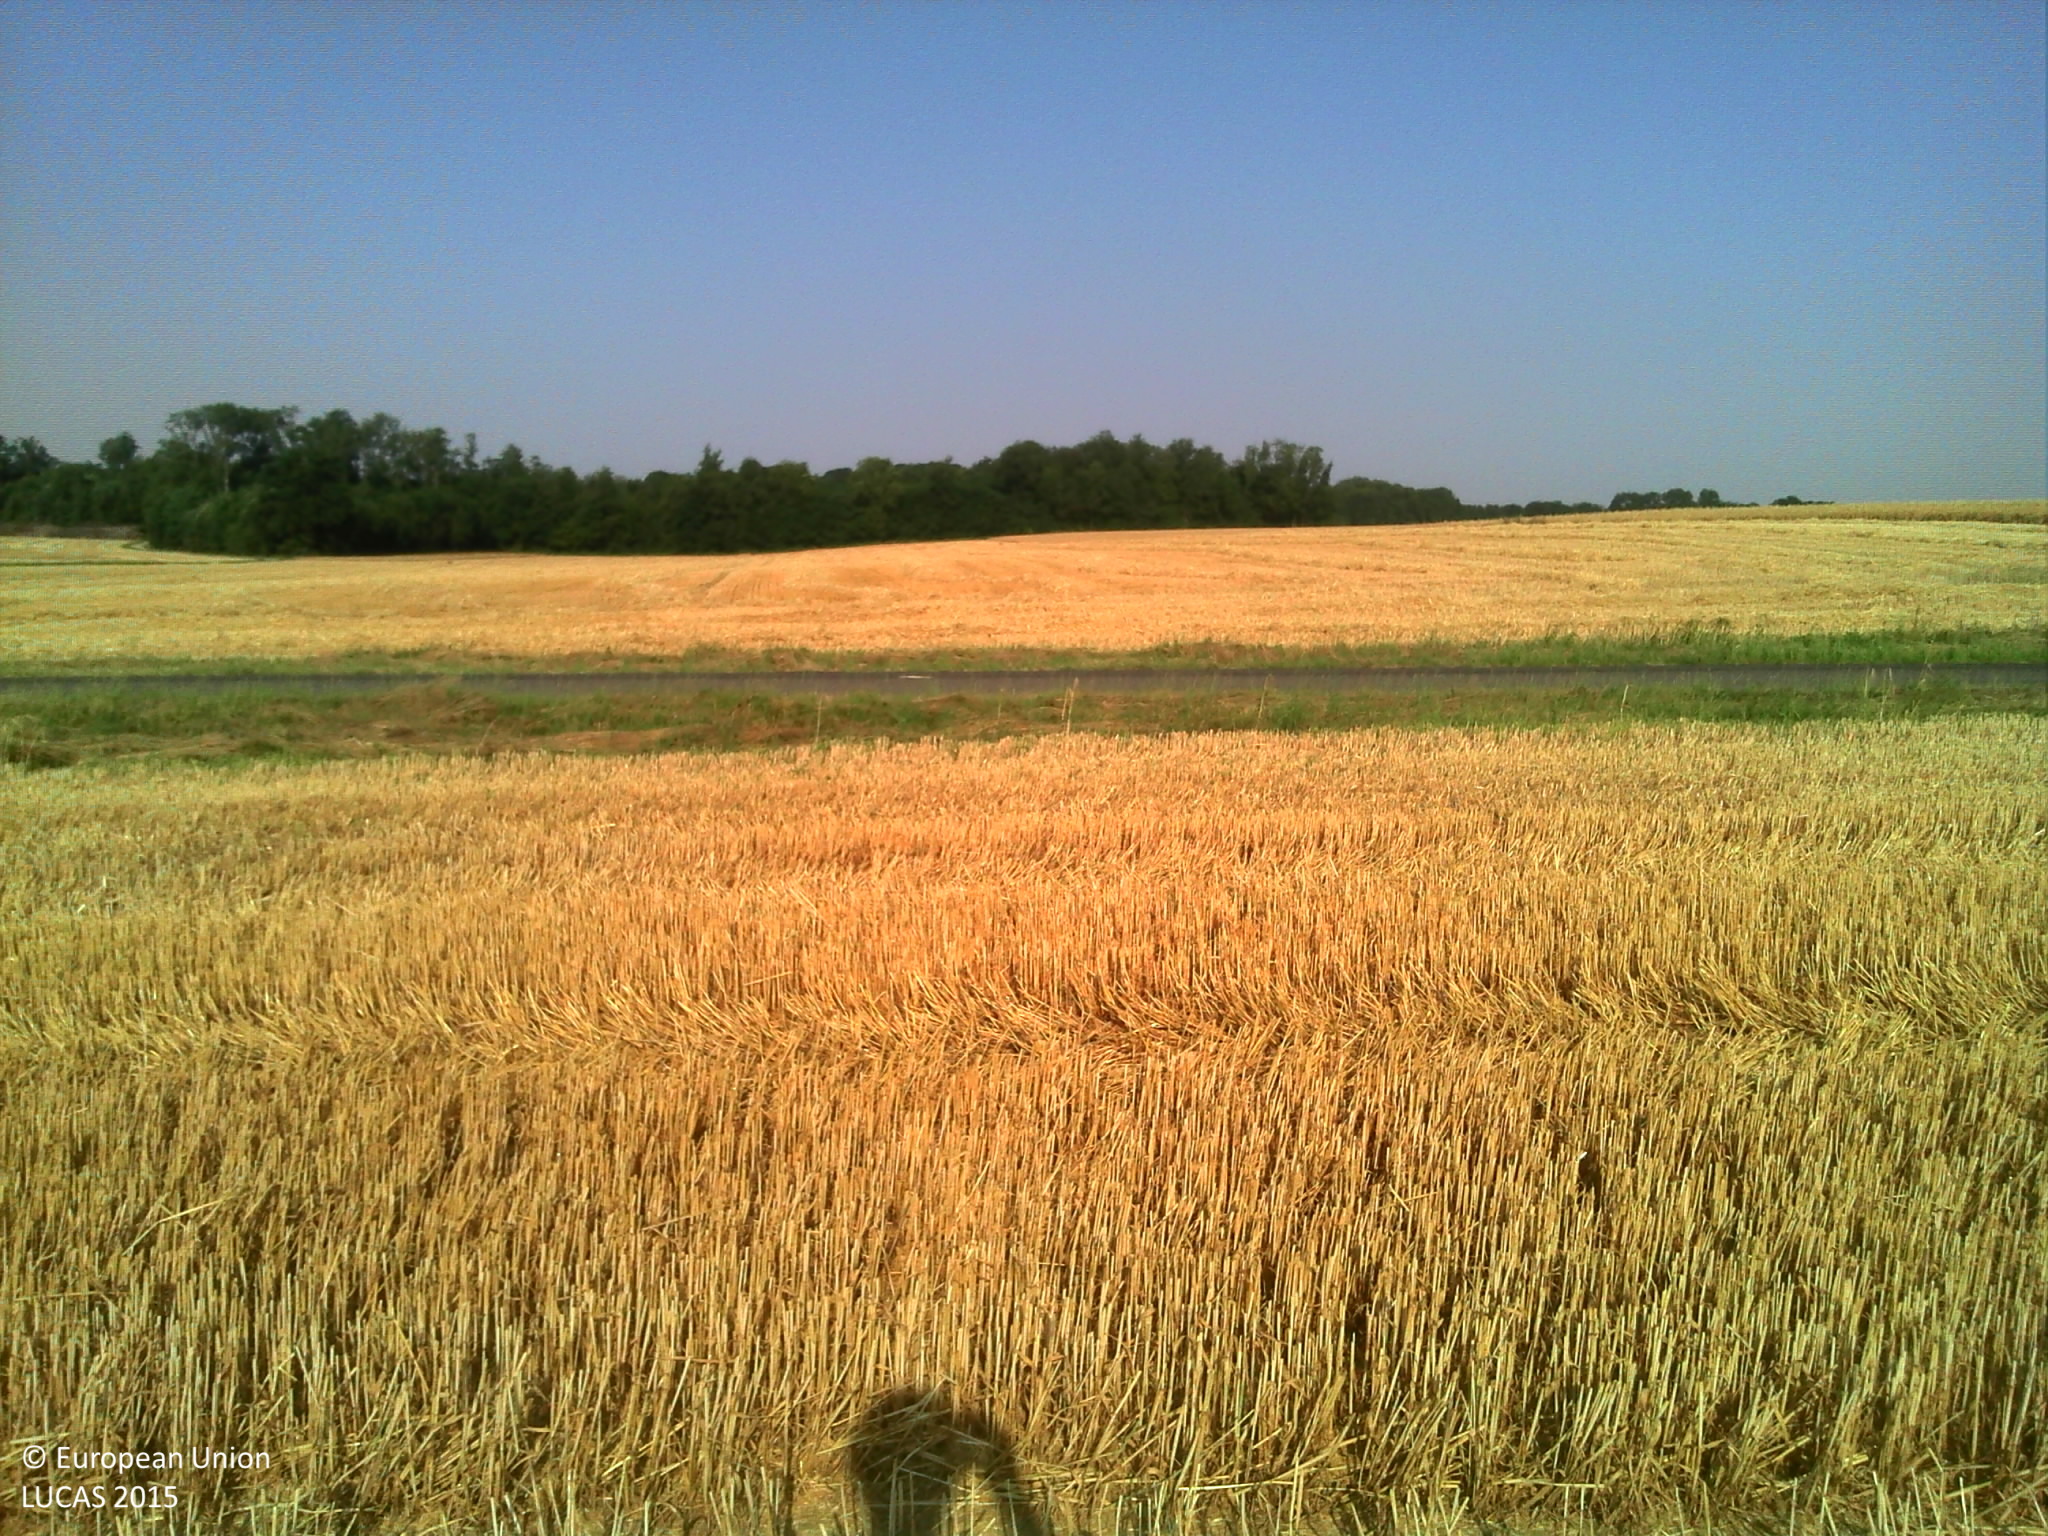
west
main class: Cropland
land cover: Barley
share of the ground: > 75 %
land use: Agriculture (excluding fallow land and kitchen gardens)
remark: Harvested field
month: July
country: FR
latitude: 48.8551
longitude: 5.1326
